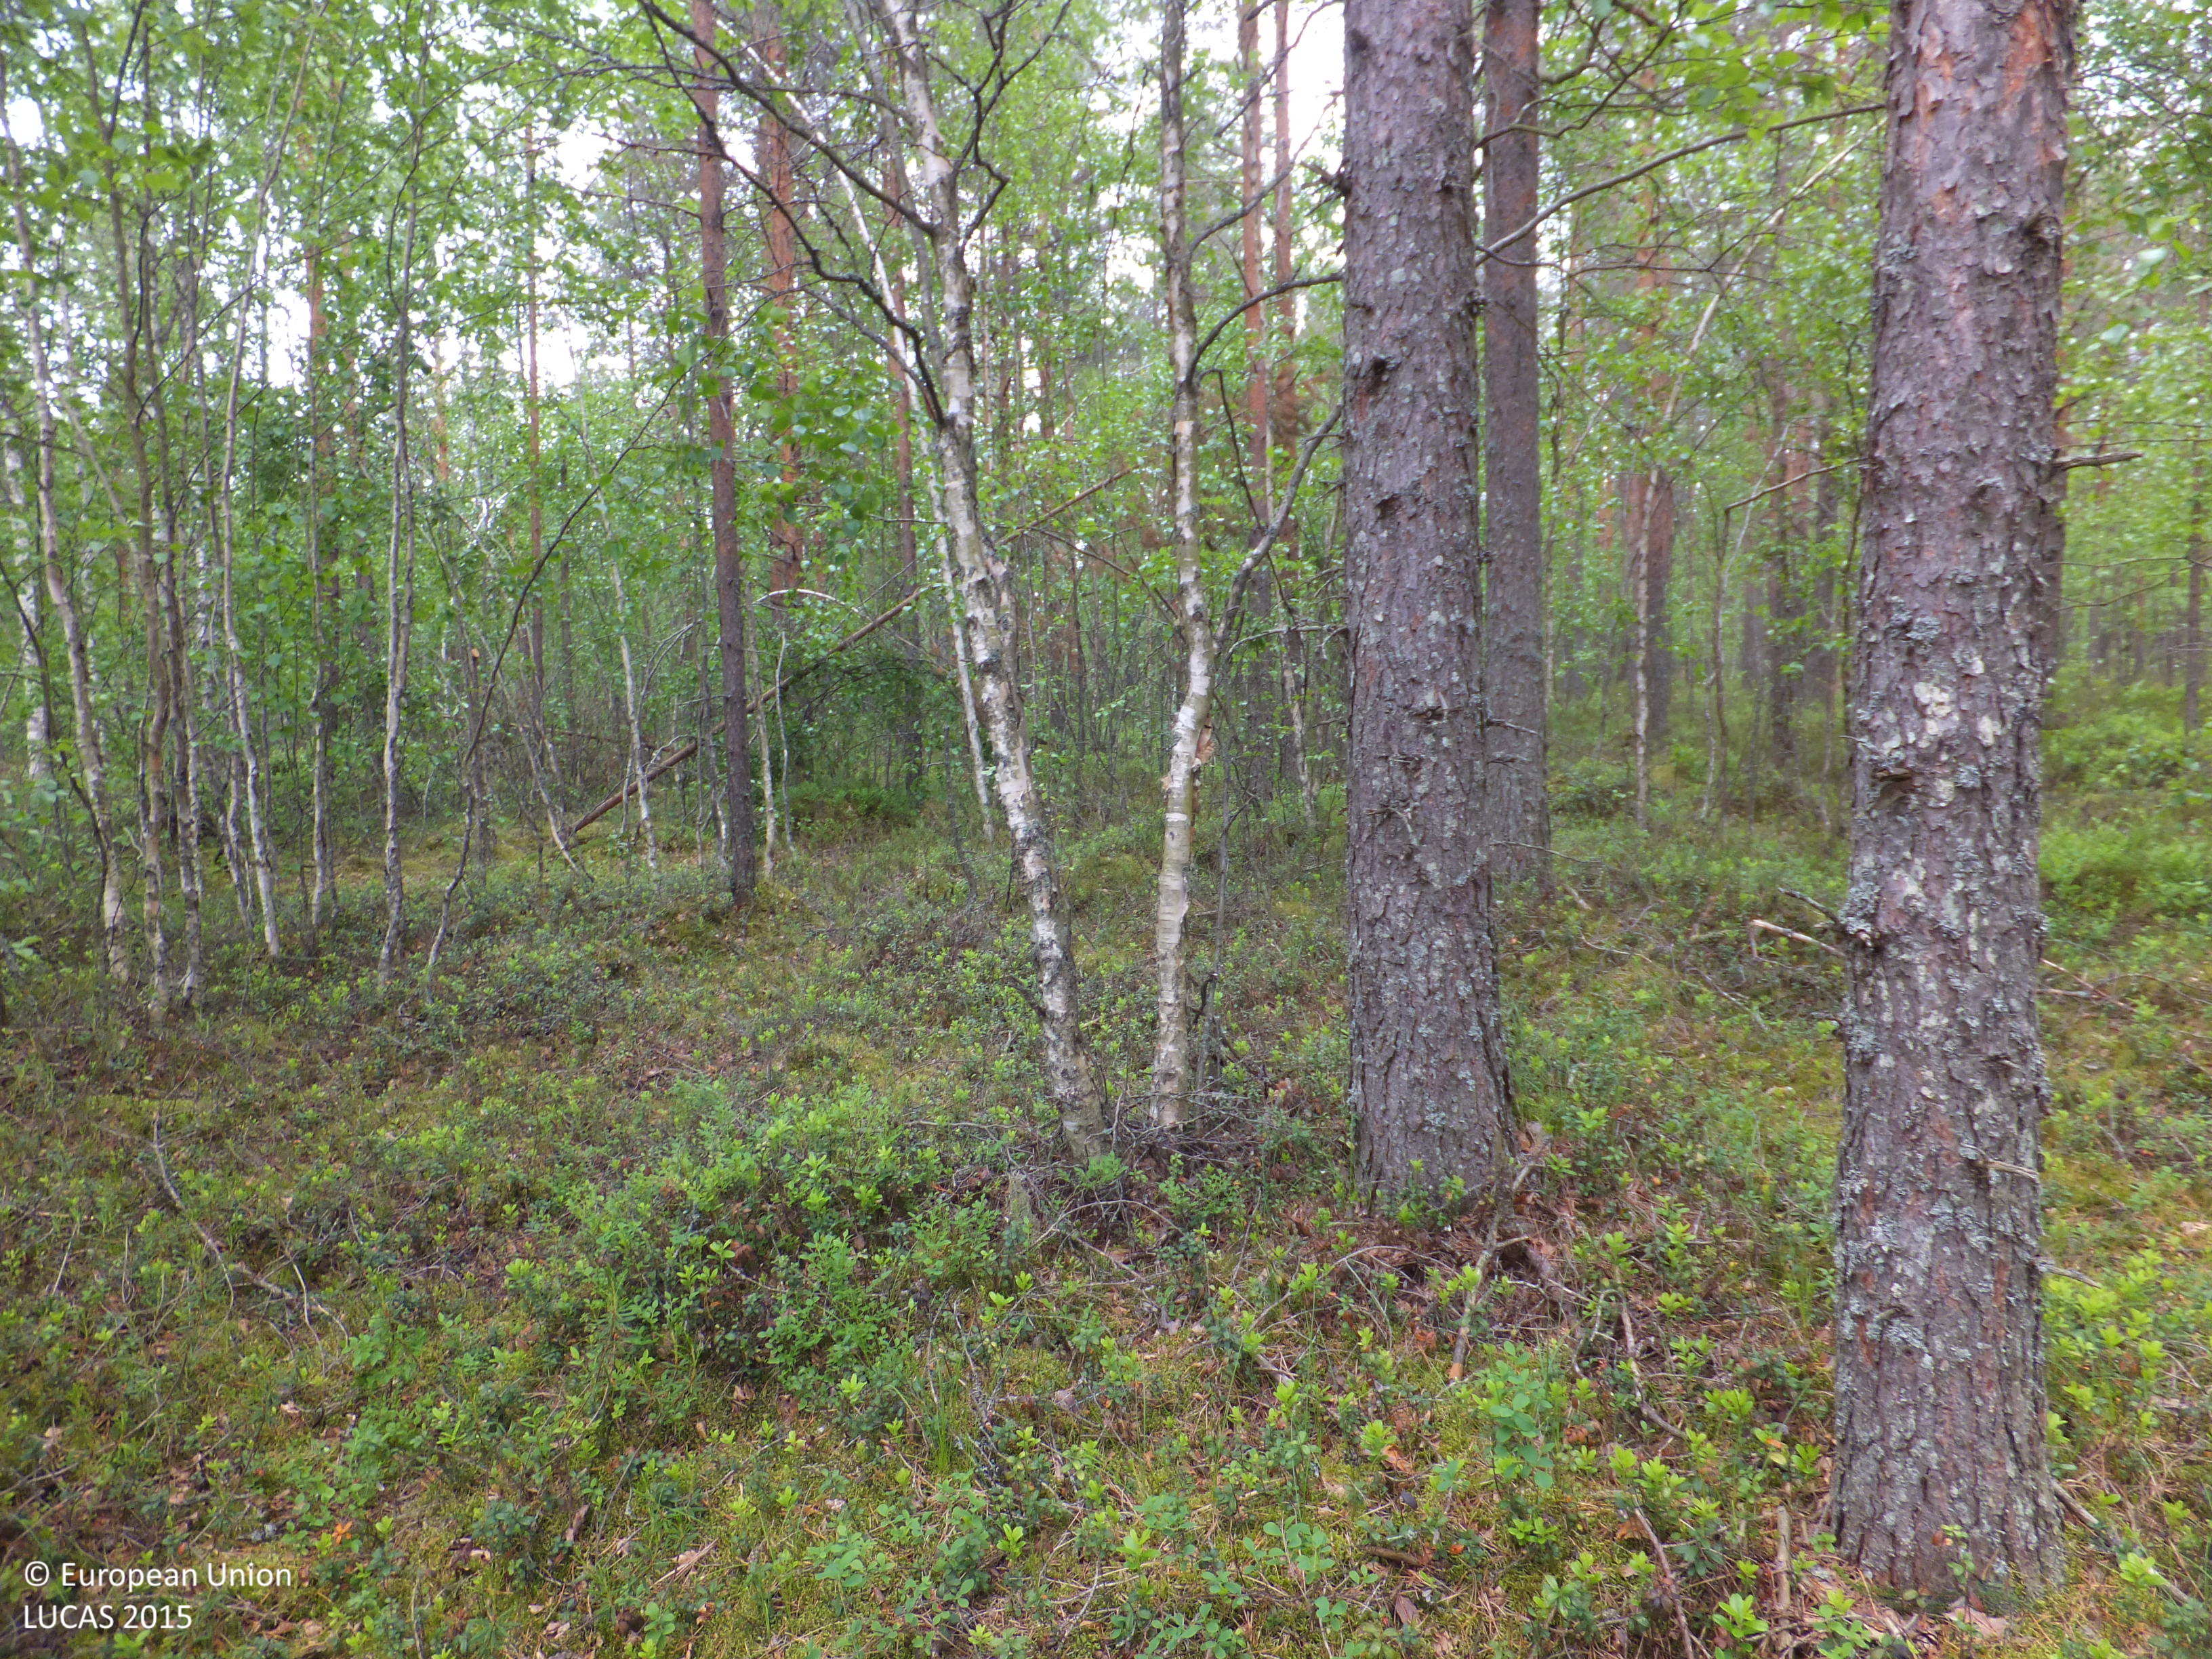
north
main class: Woodland
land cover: Pine dominated mixed woodland
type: boreal forest
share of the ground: > 75 %
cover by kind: coniferous forest trees 45 %, broadleaved forest trees 25 %, shrubs 20 %, lichens and mosses 10 %
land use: Forestry
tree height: > 5 m
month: June
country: FI
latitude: 63.5265
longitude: 24.0860
